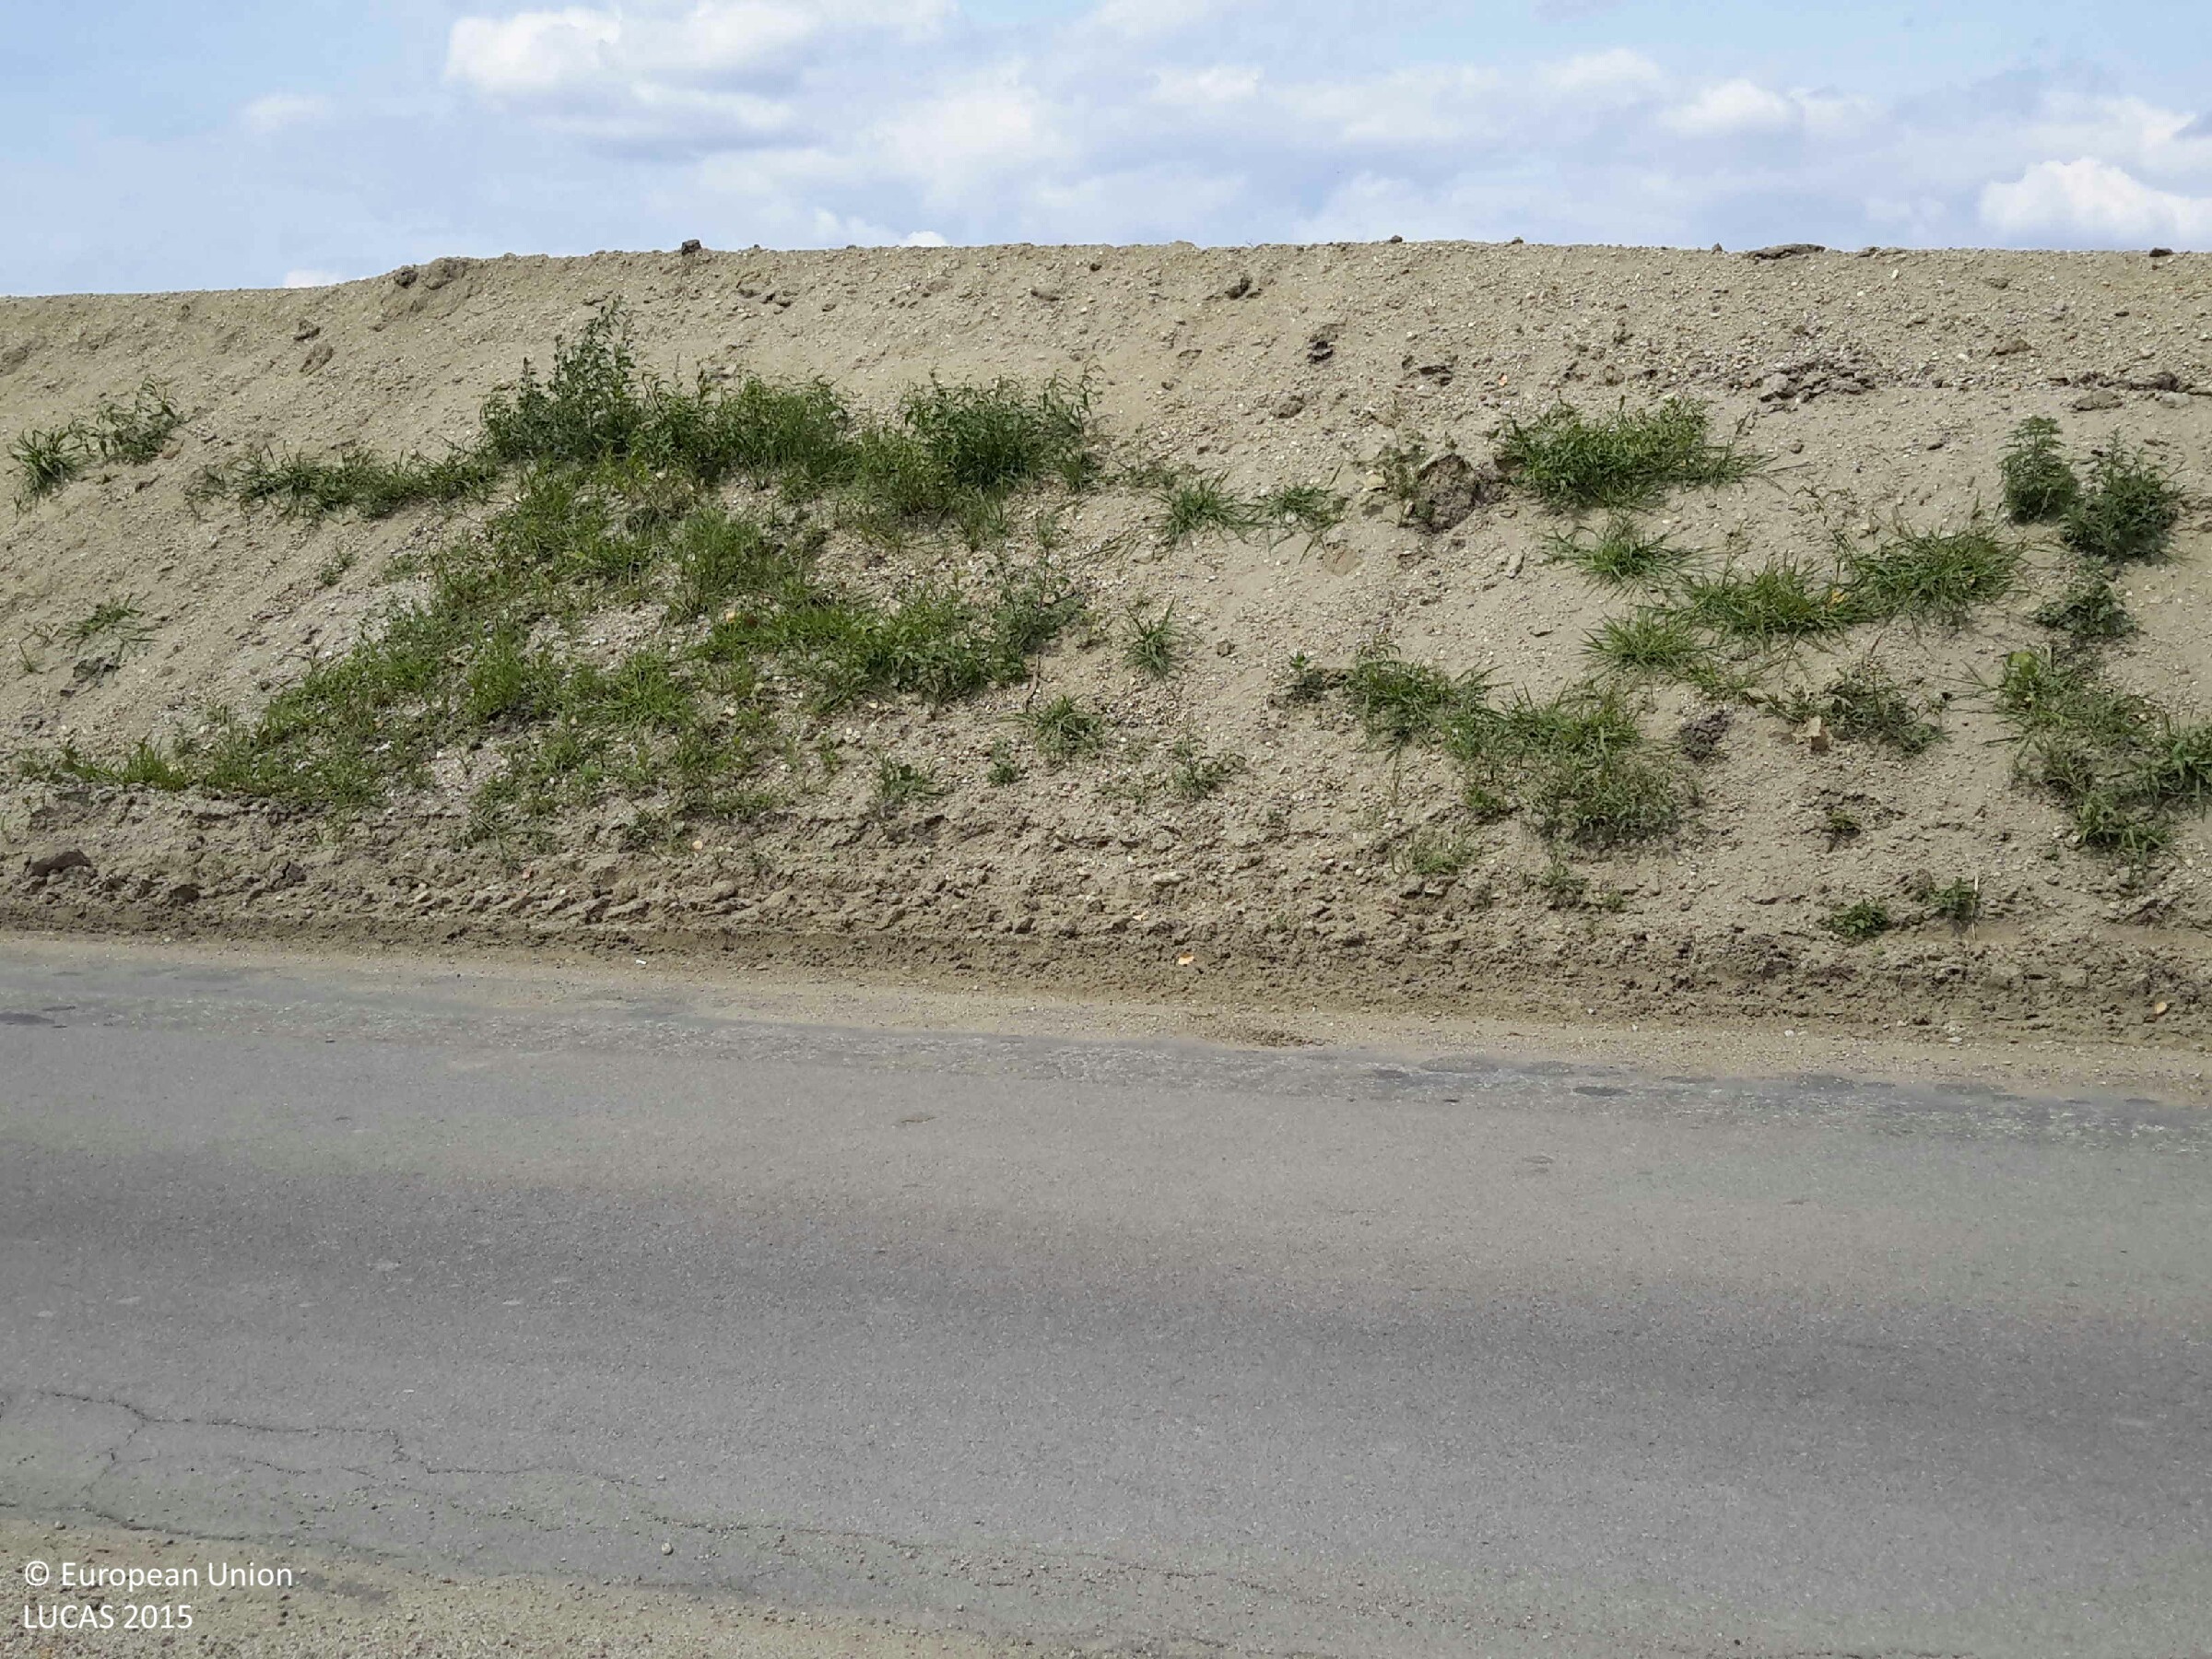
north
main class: Cropland
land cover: Apple fruit
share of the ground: 25 - 50 %
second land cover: Grassland without tree/shrub cover
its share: 50 - 75 %
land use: Agriculture (excluding fallow land and kitchen gardens)
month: July
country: HU
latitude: 47.5350
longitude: 17.2200
